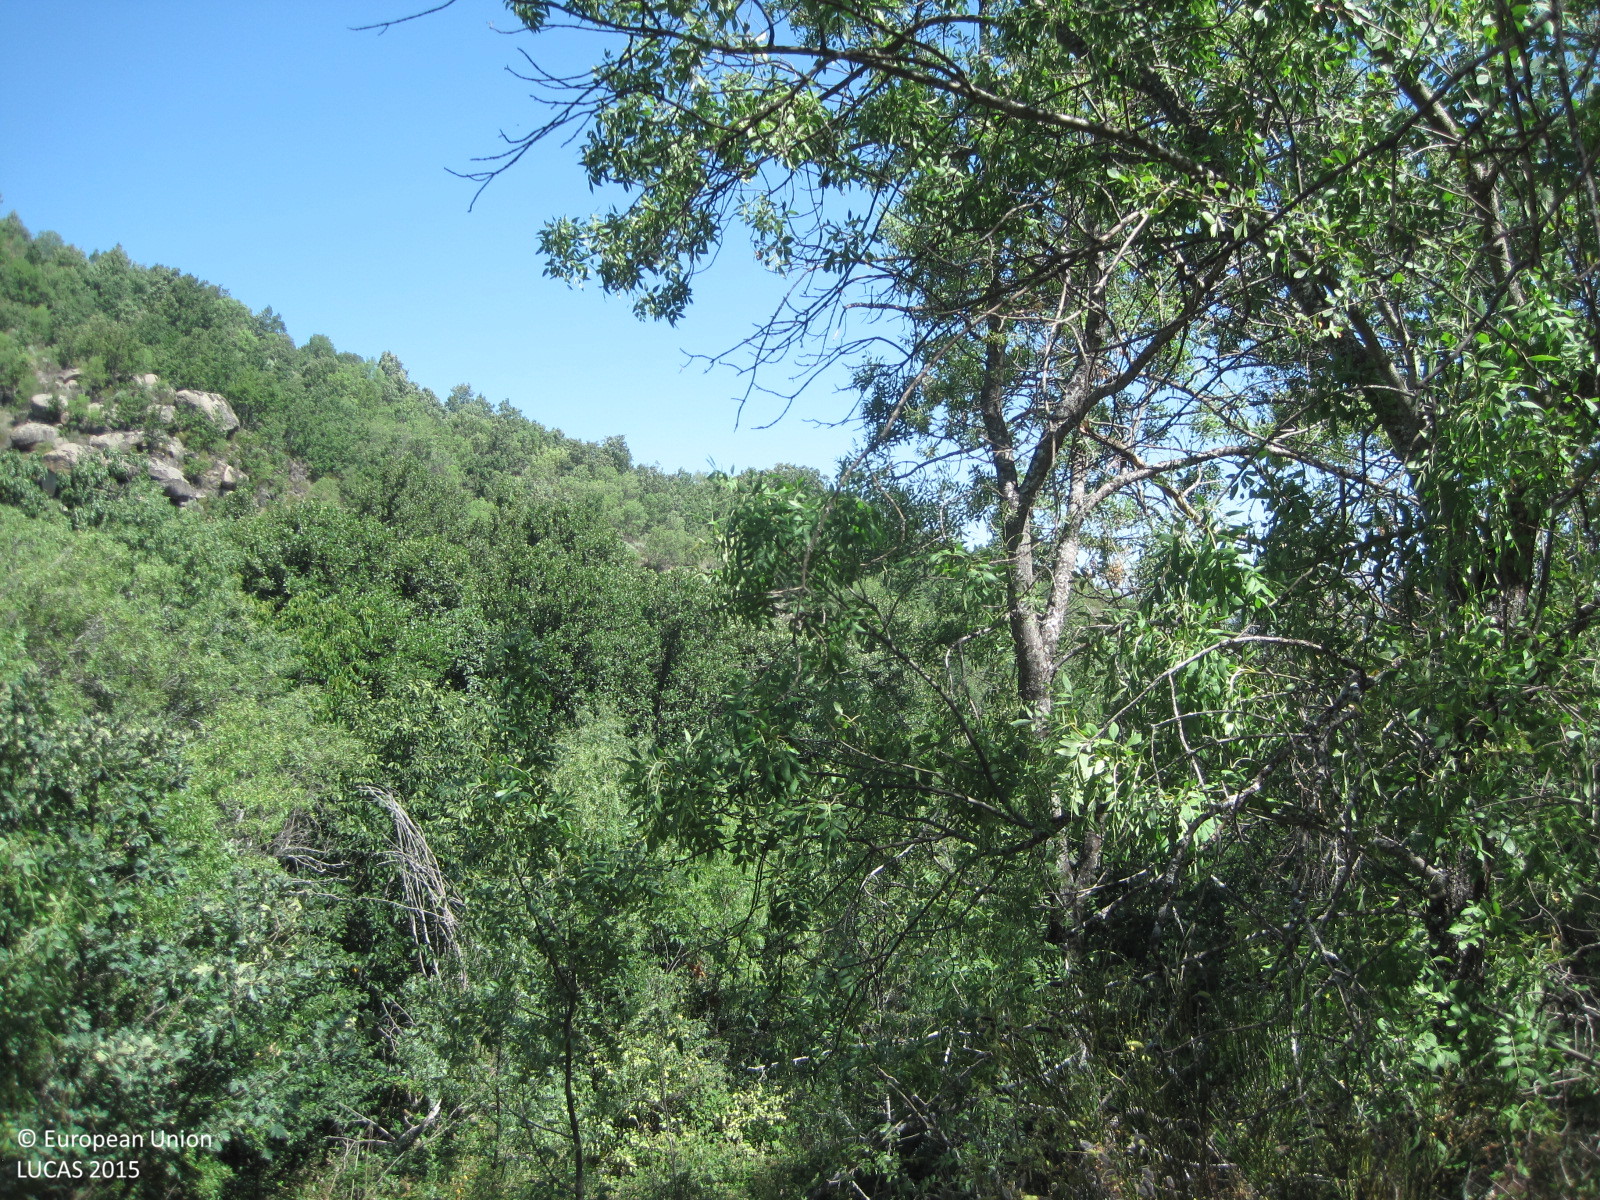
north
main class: Woodland
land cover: Broadleaved woodland
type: broadleaved evergreen forest
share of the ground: > 75 %
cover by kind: broadleaved forest trees 90 %, shrubs 5 %, herbaceous plants 5 %
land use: Semi-natural and natural areas not in use
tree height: > 5 m
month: July
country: ES
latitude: 40.3663
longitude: -4.8092
